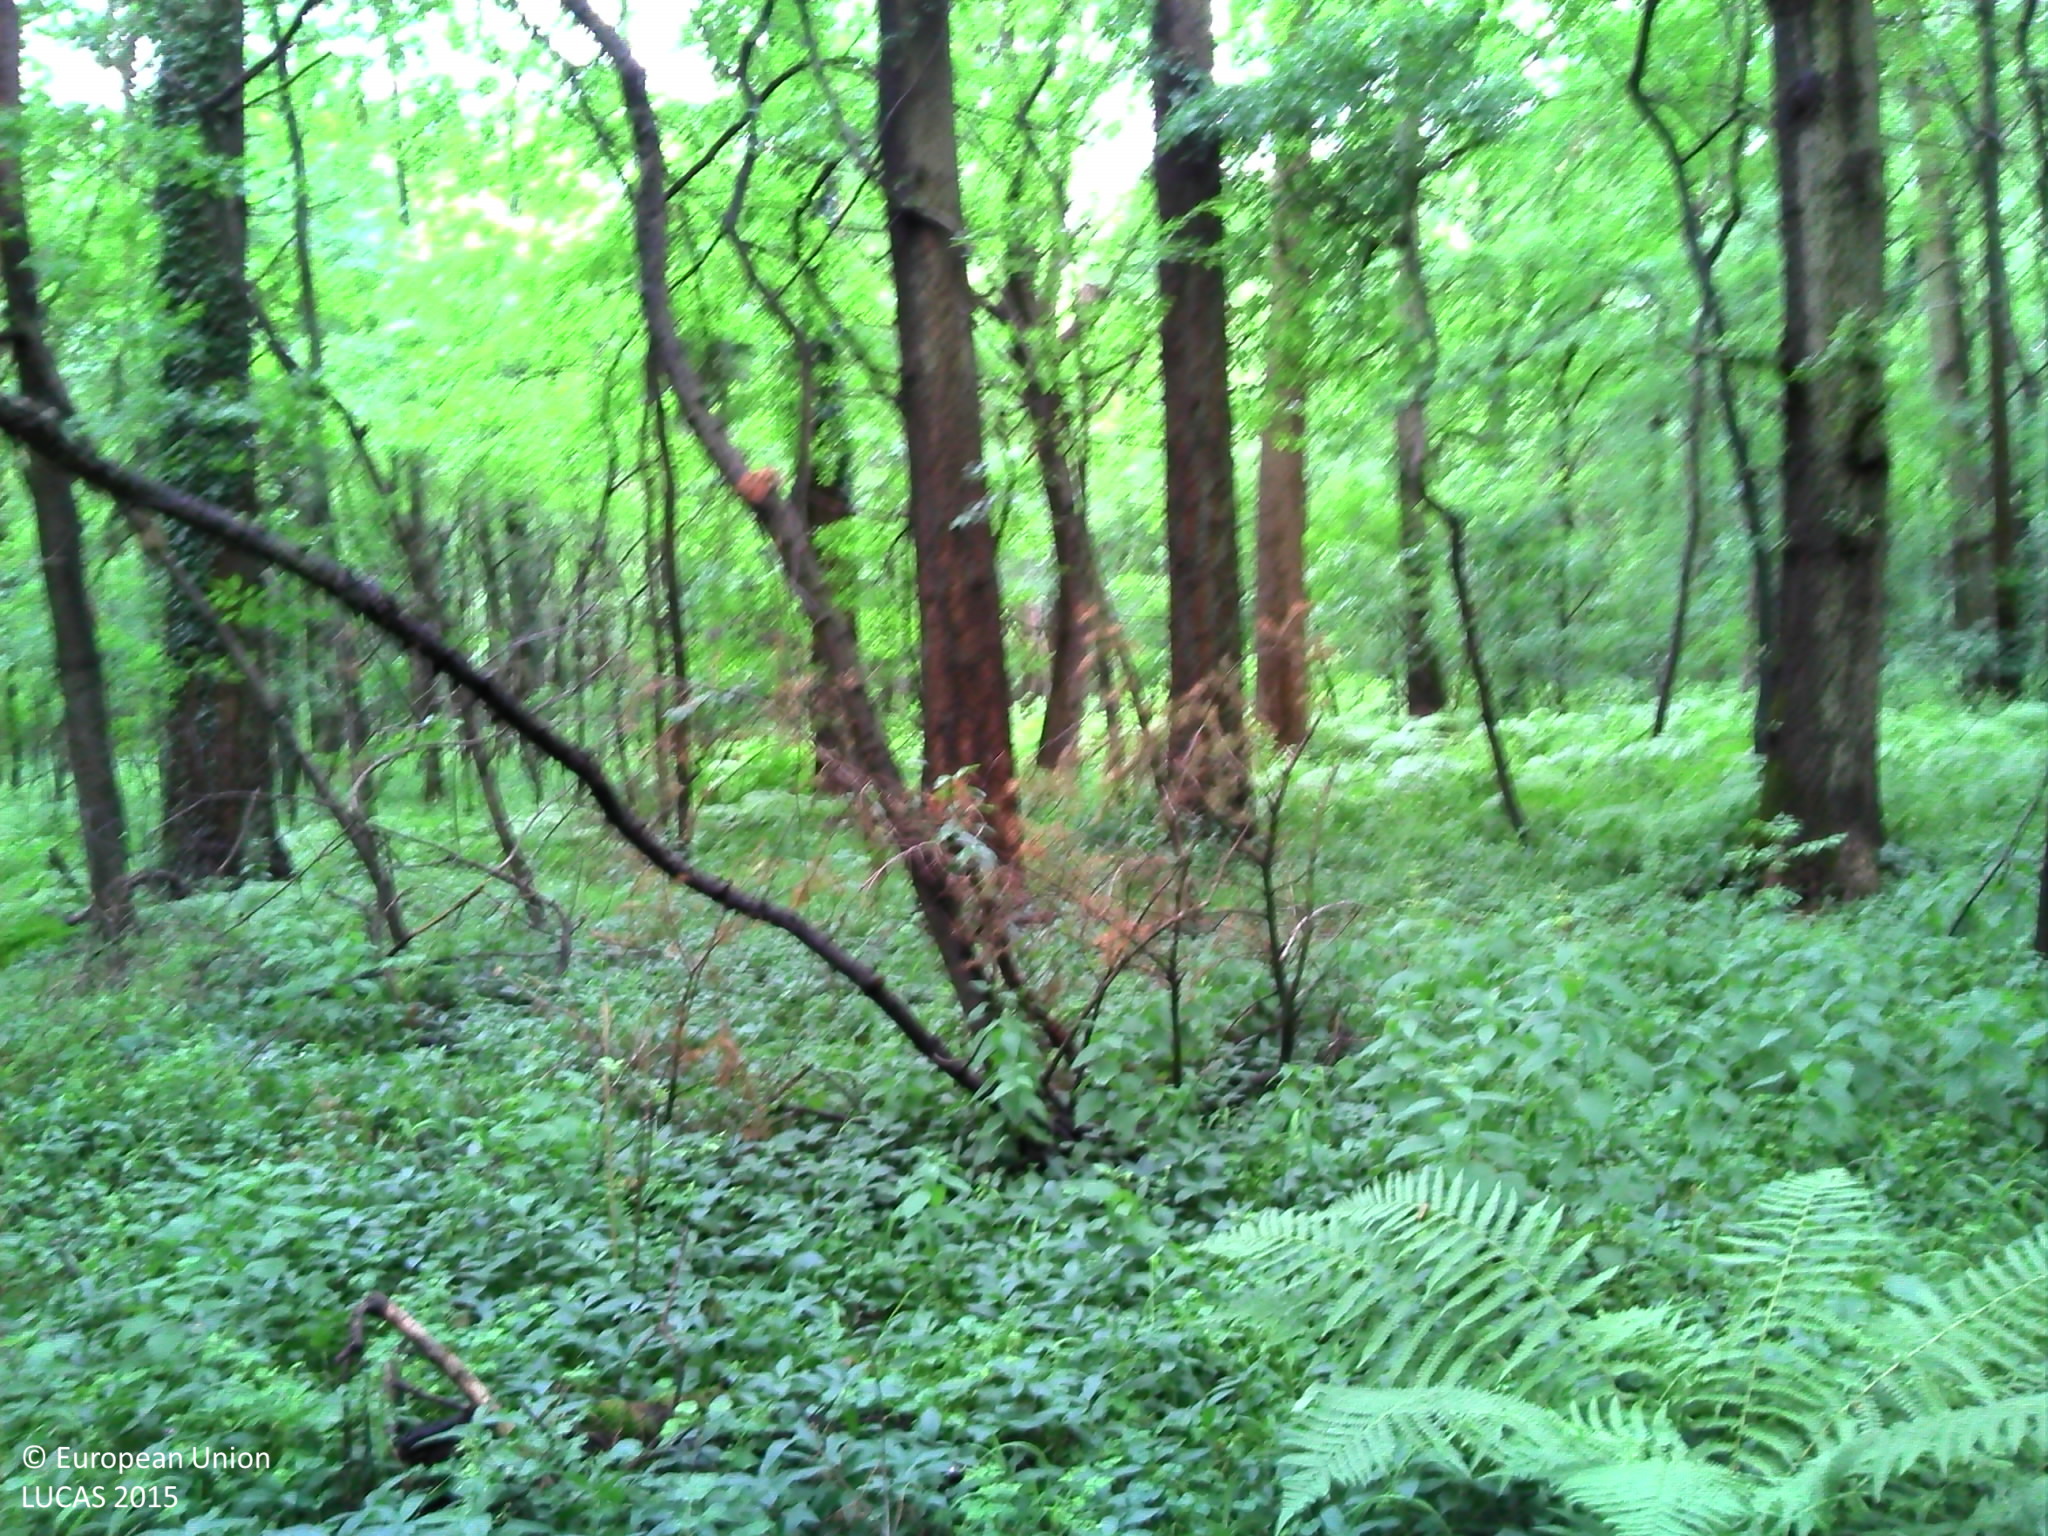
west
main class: Woodland
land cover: Broadleaved woodland
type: mesophytic deciduous forest
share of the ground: > 75 %
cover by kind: broadleaved forest trees 75 %, herbaceous plants 20 %, shrubs 5 %
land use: Forestry
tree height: > 5 m
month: June
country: BE
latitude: 50.4952
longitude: 4.0031
